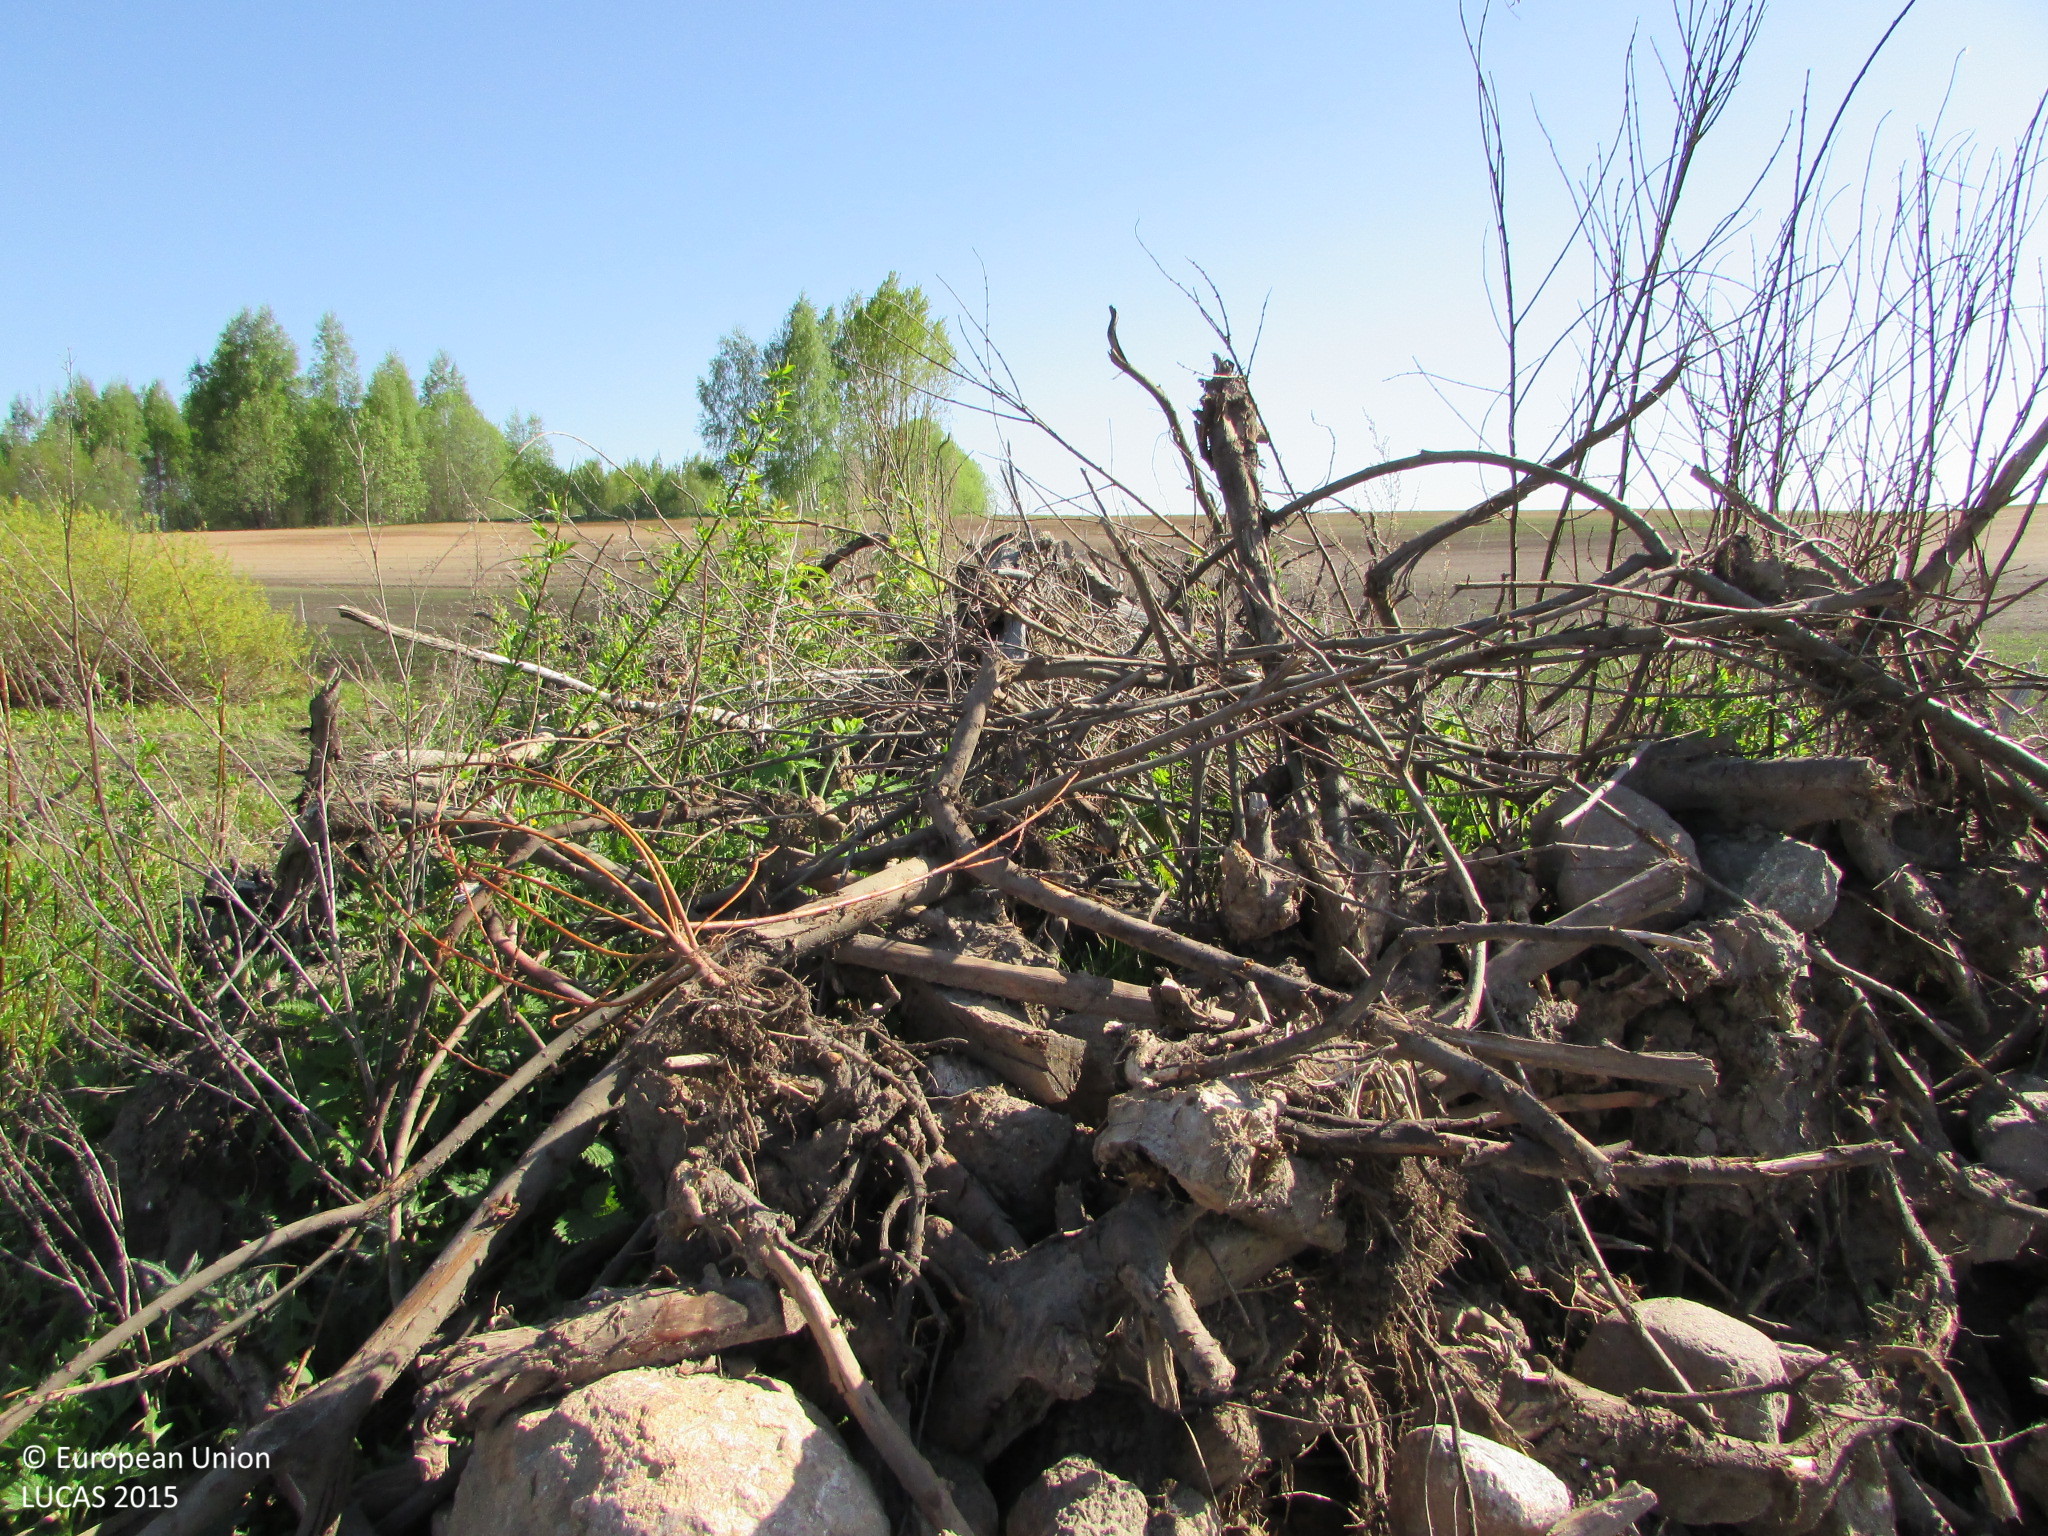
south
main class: Grassland
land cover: Spontaneously vegetated surfaces
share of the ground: 50 - 75 %
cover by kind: herbaceous plants 60 %, shrubs 5 %
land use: Semi-natural and natural areas not in use
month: May
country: LV
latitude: 55.8541
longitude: 27.5151
